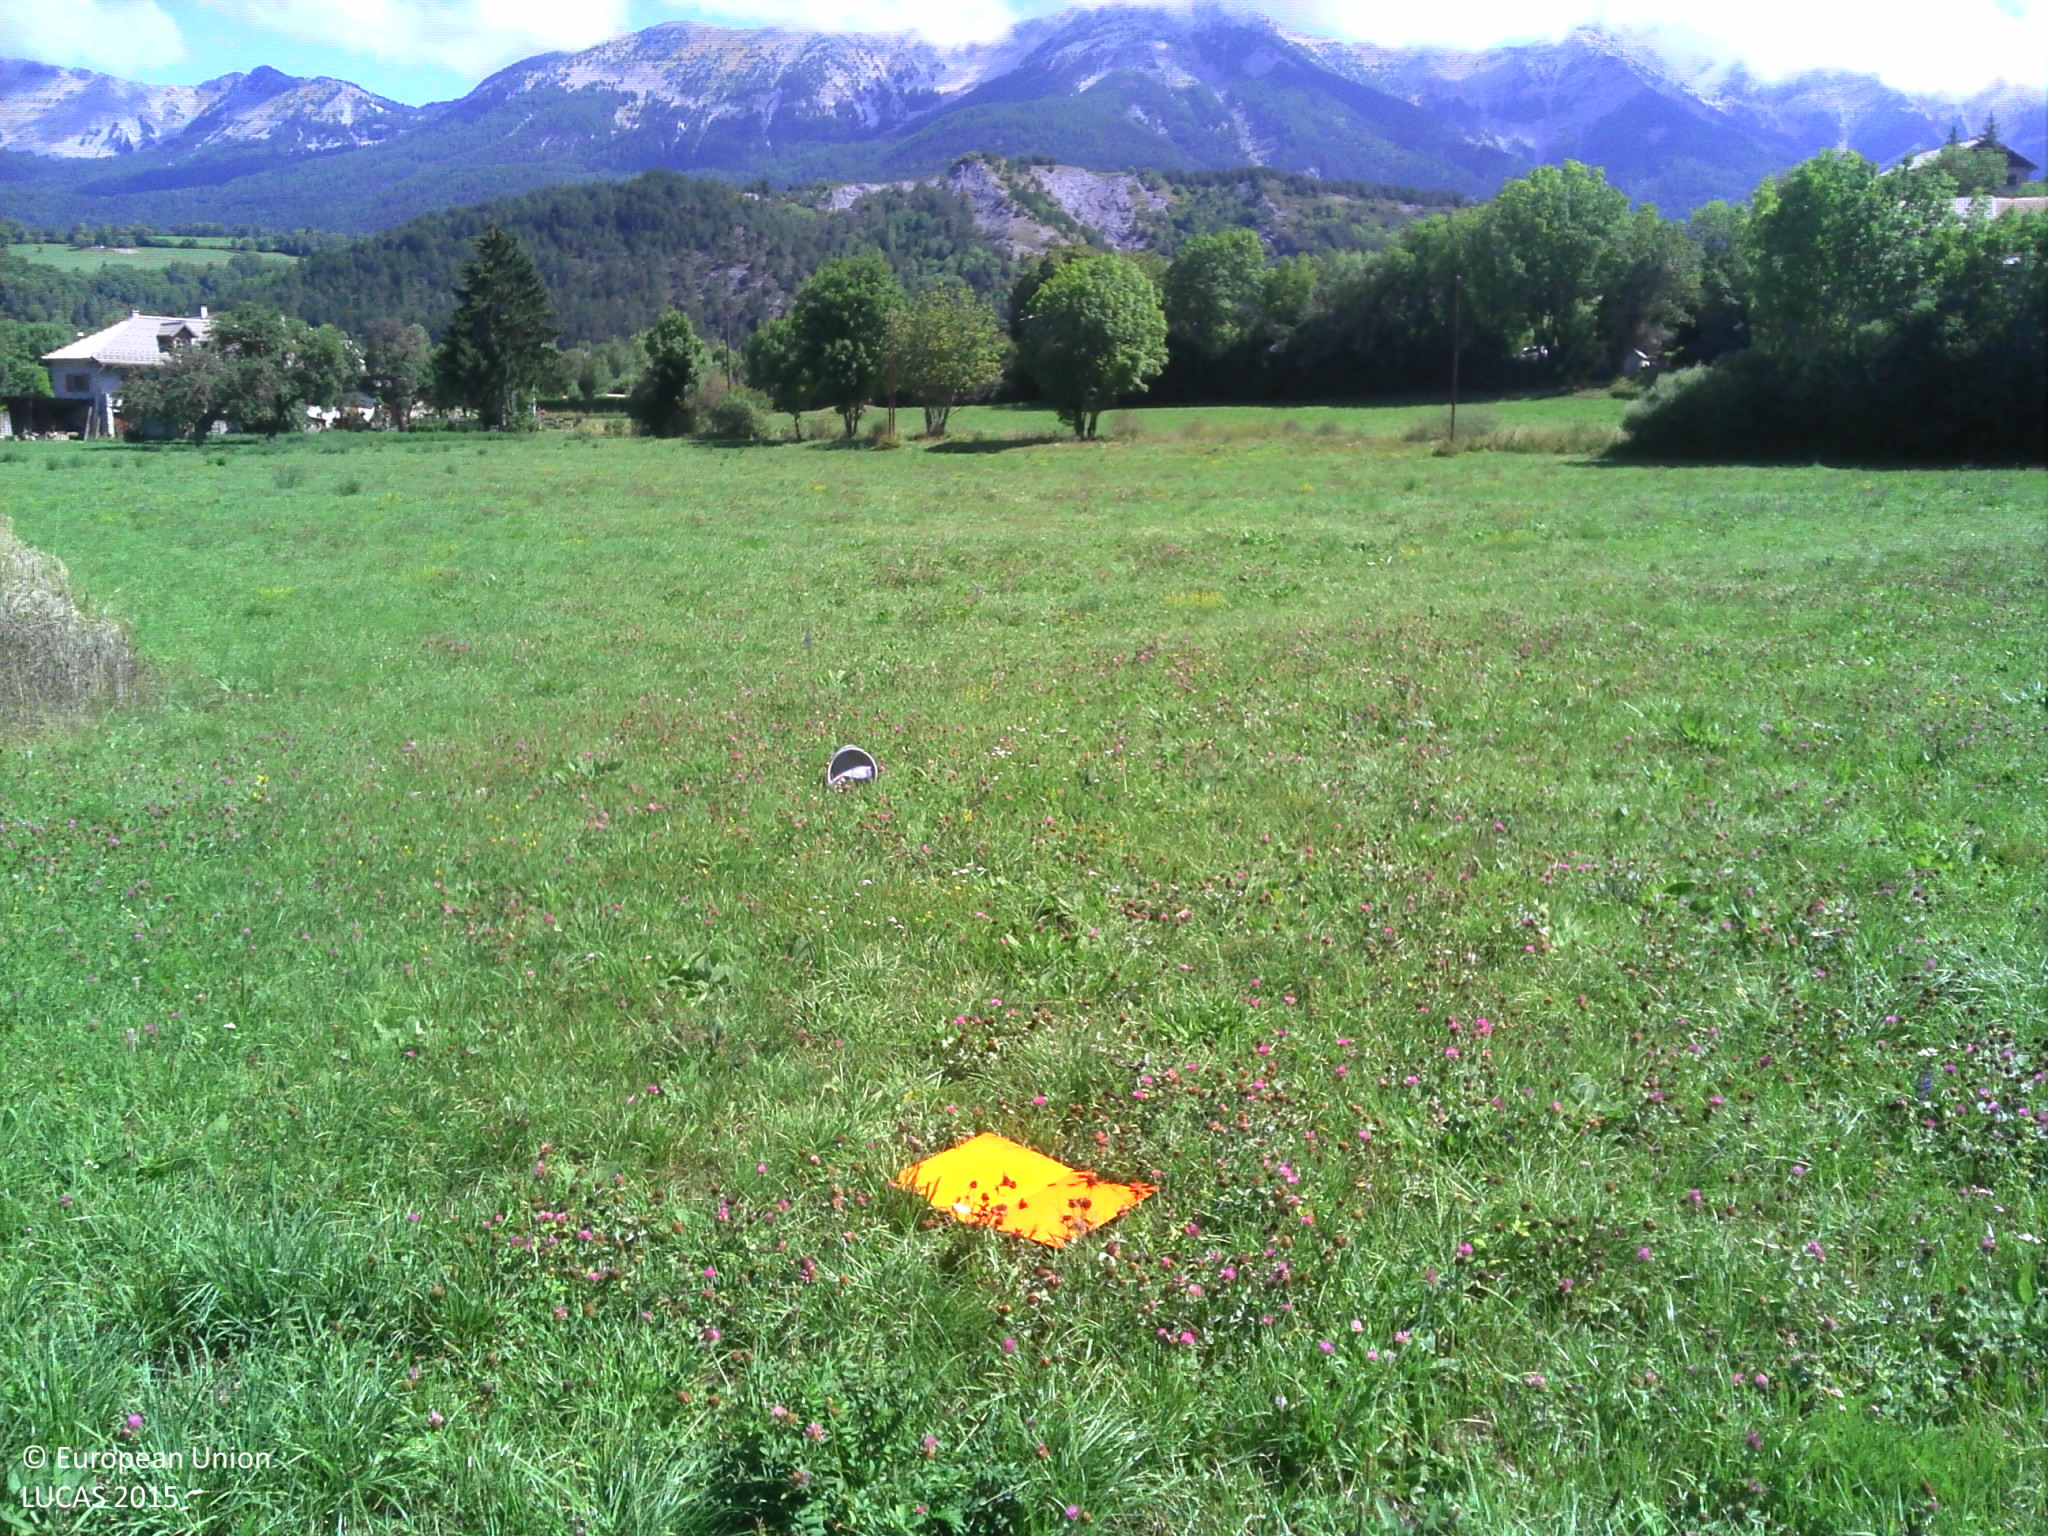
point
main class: Grassland
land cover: Grassland without tree/shrub cover
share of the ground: > 75 %
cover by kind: herbaceous plants 100 %
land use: Agriculture (excluding fallow land and kitchen gardens)
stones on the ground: < 10 %
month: August
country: FR
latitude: 44.3408
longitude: 6.3569
